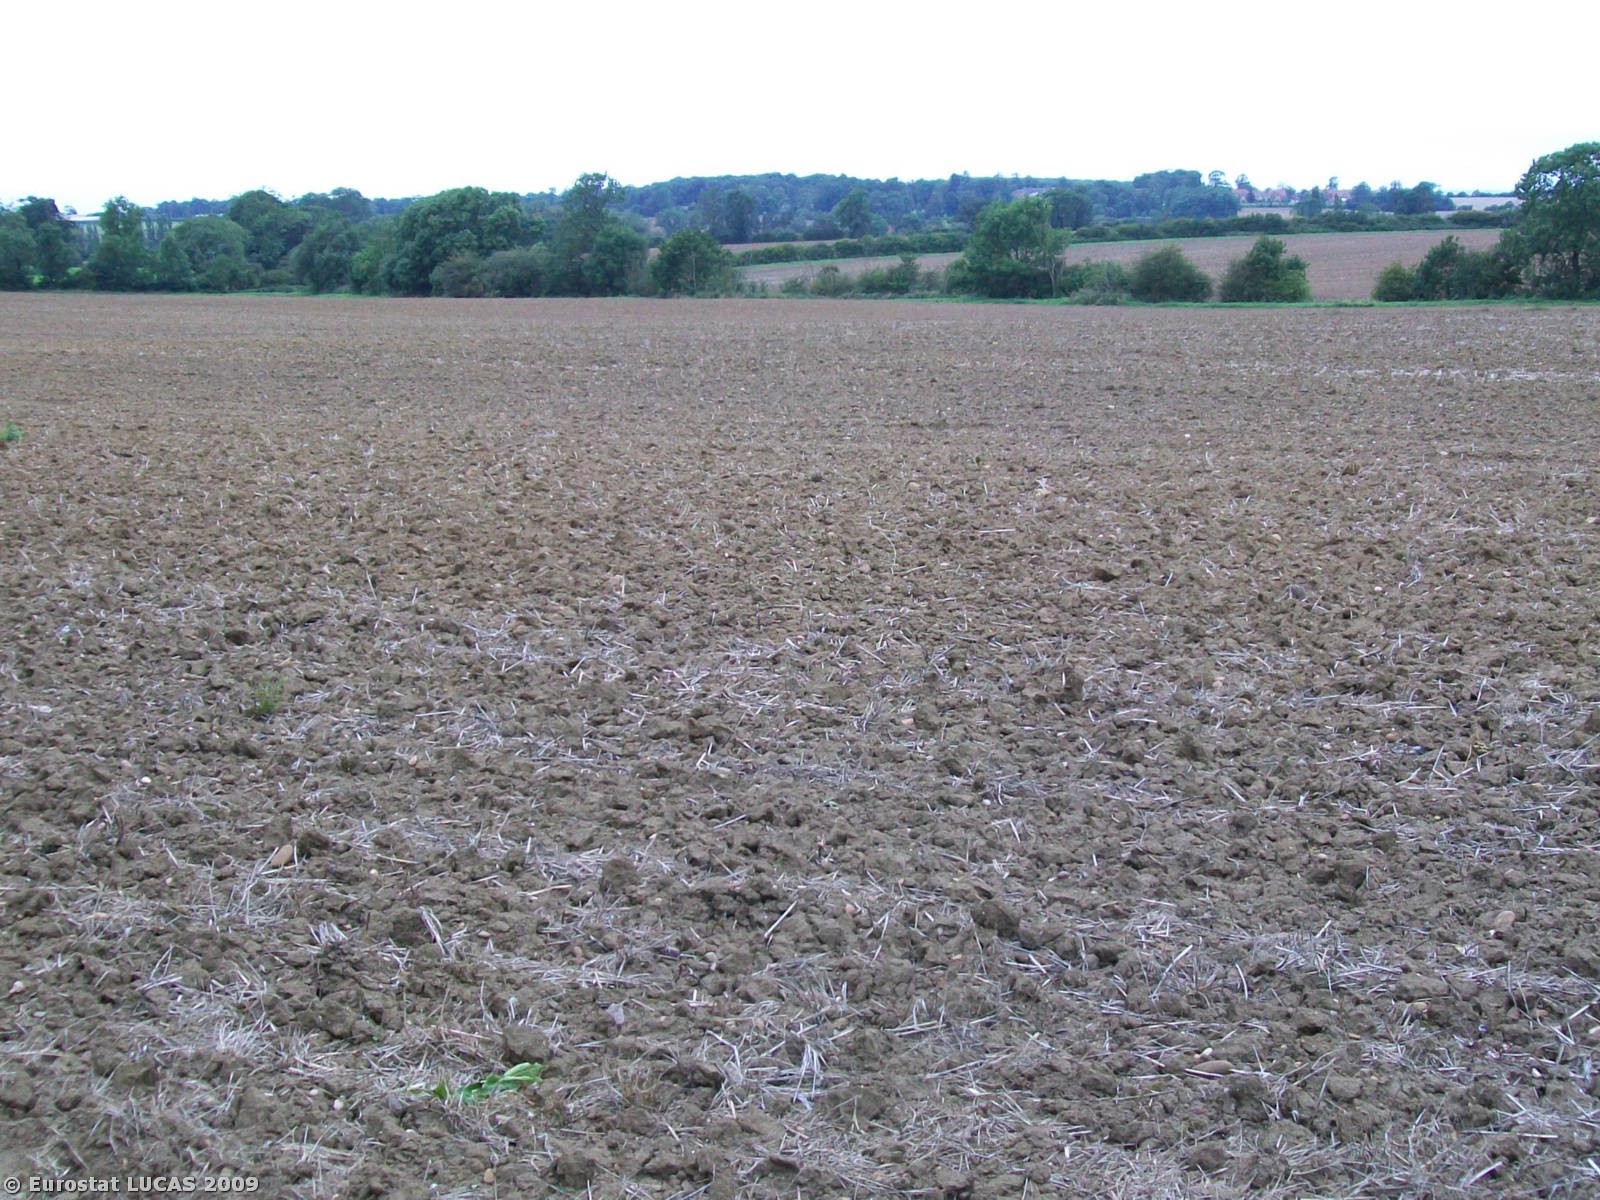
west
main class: Grassland
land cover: Grassland without tree/shrub cover
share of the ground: > 75 %
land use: Agriculture (excluding fallow land and kitchen gardens)
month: August
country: GB
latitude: 52.5895
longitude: -1.0116
